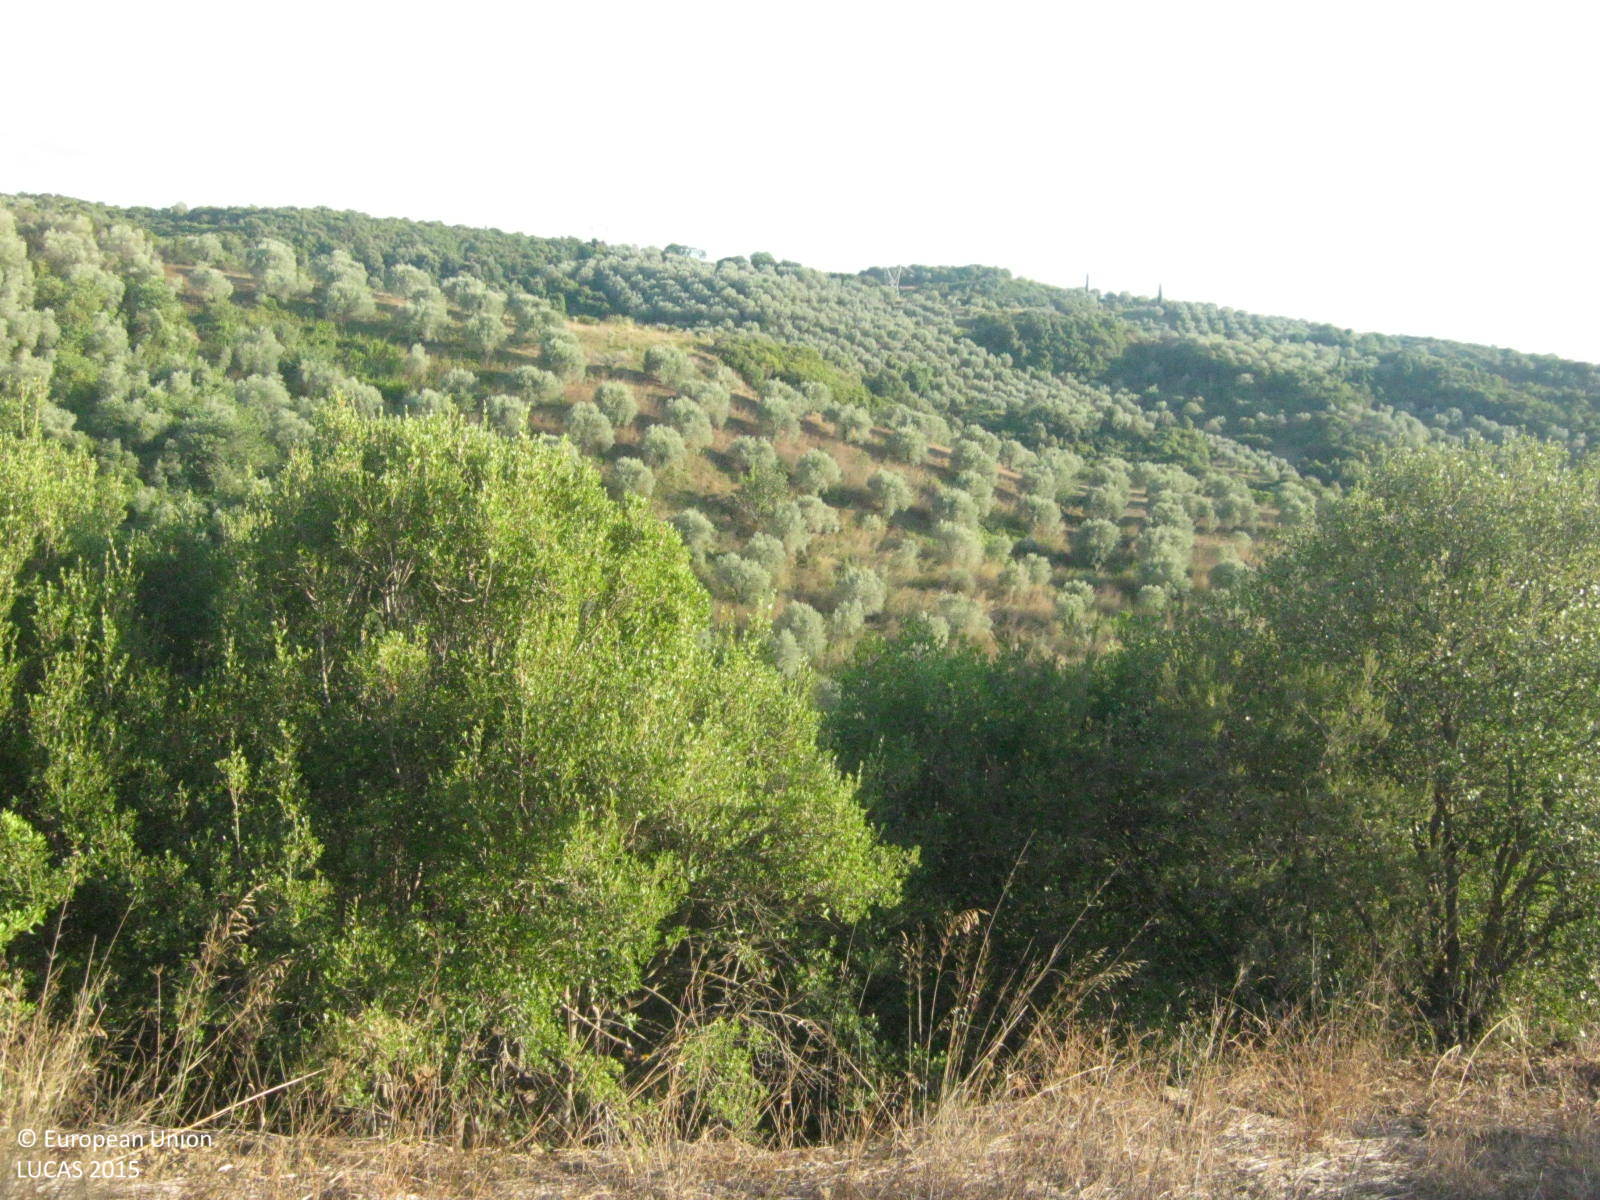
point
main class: Shrubland
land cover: Shrubland with sparse tree cover
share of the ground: > 75 %
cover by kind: shrubs 85 %, broadleaved forest trees 5 %, herbaceous plants 5 %, unconsolidated bare surface 5 %
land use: Semi-natural and natural areas not in use
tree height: < 5 m
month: August
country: GR
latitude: 39.1049
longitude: 21.1098
